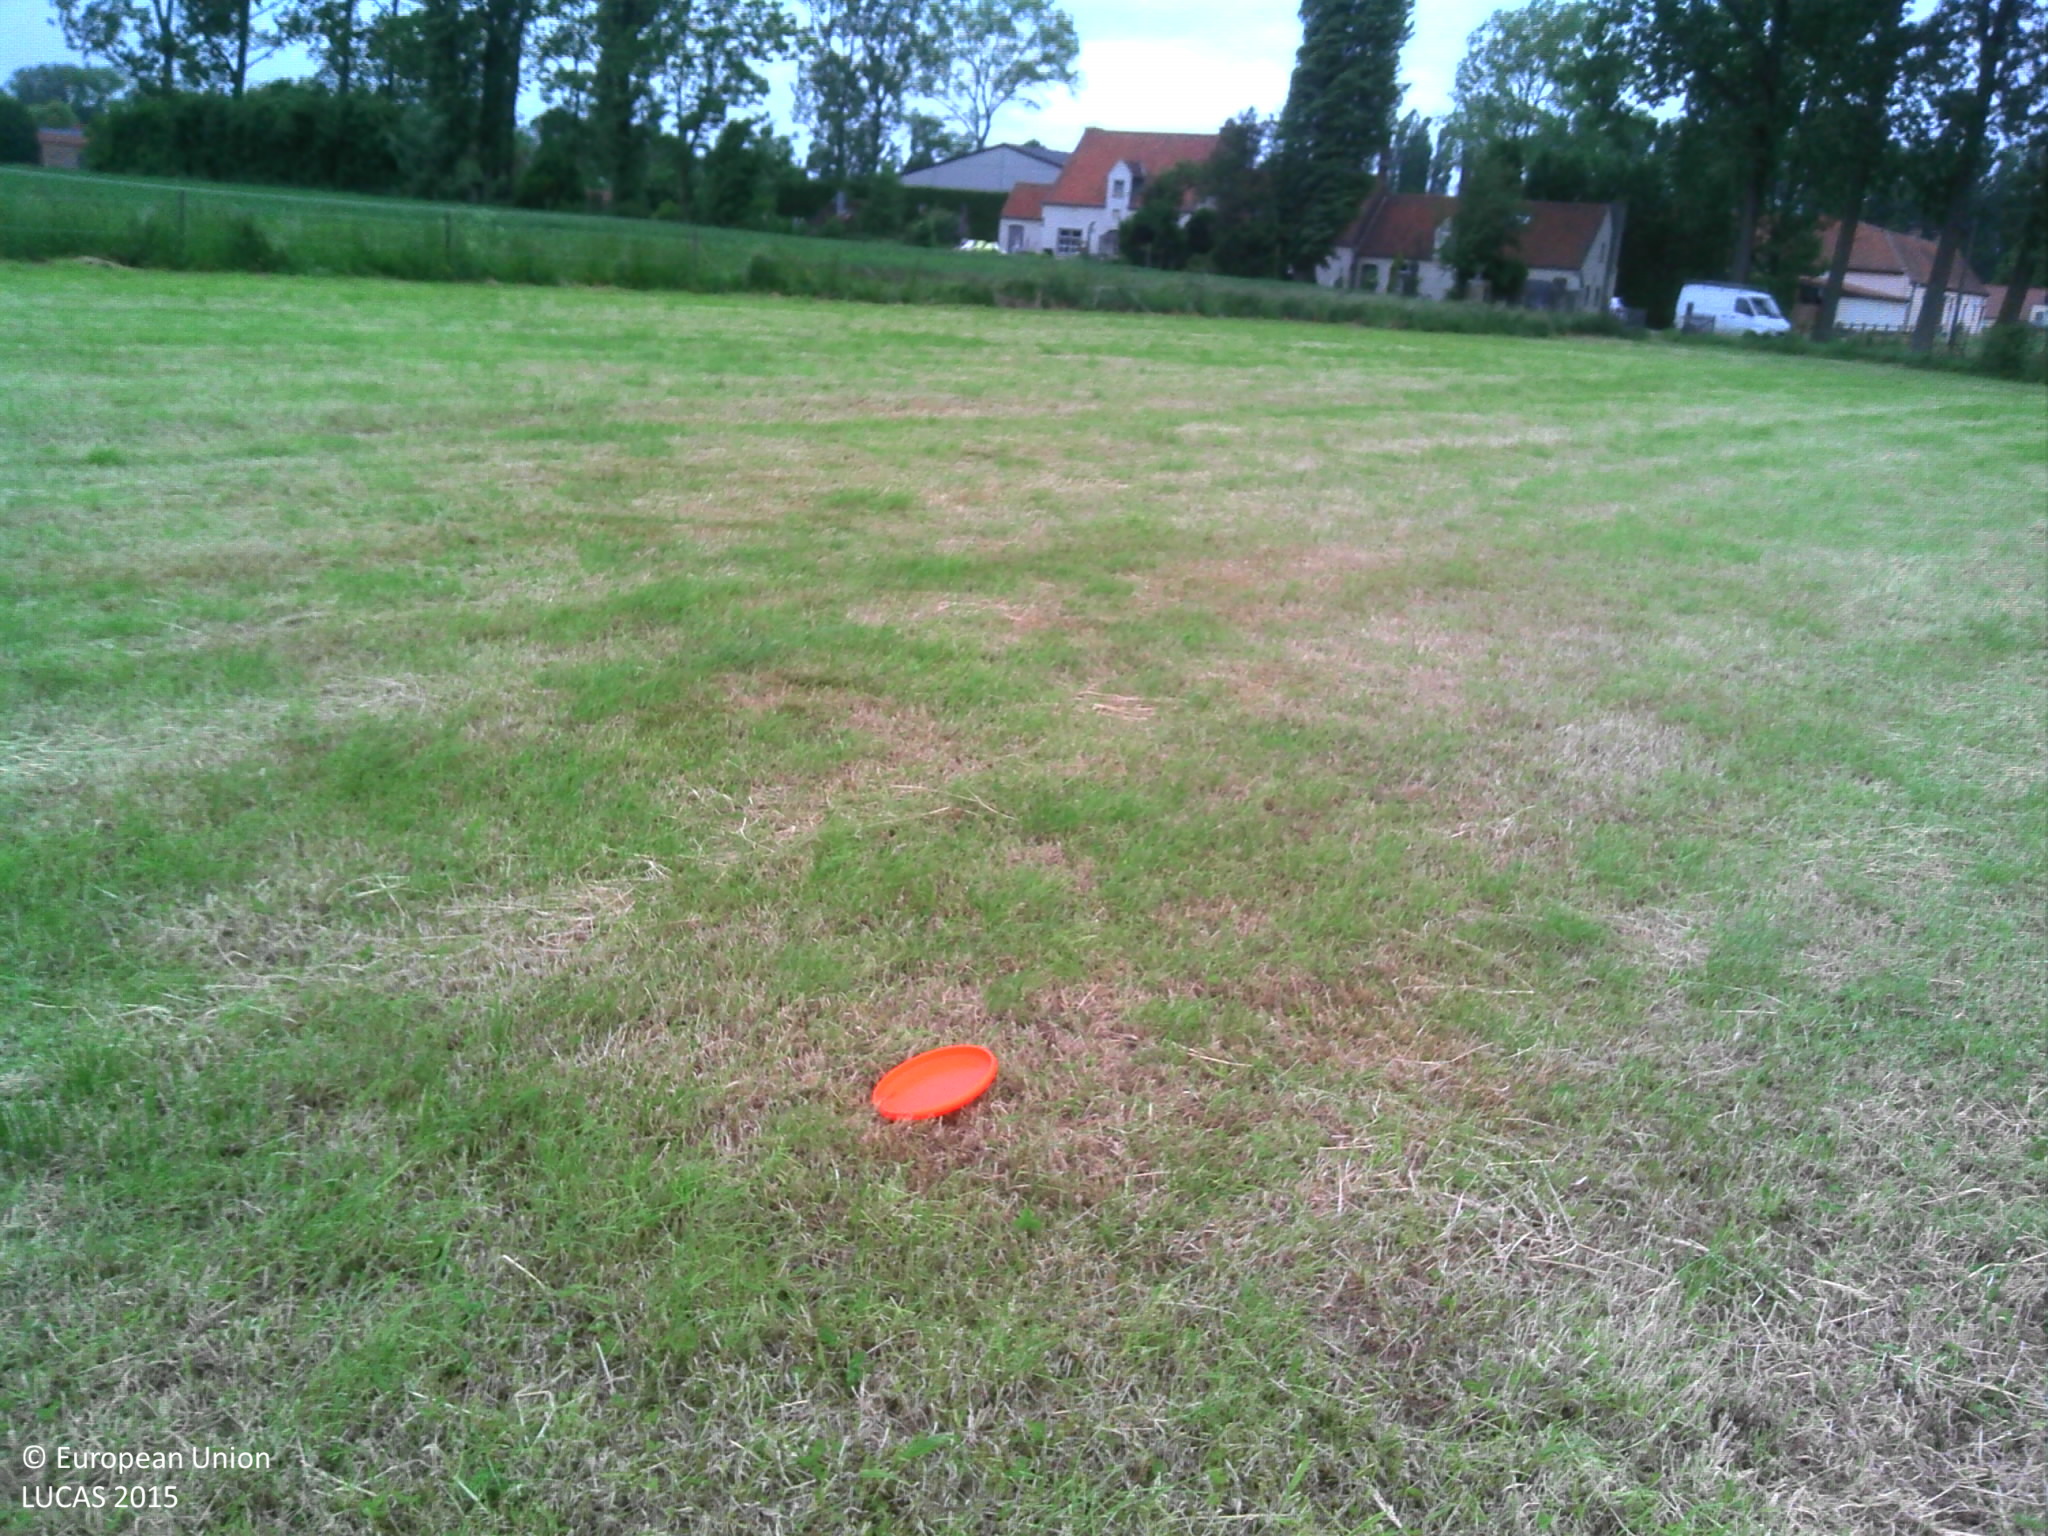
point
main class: Grassland
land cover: Grassland without tree/shrub cover
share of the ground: > 75 %
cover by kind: herbaceous plants 100 %
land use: Agriculture (excluding fallow land and kitchen gardens)
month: June
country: BE
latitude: 50.8474
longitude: 3.8436
